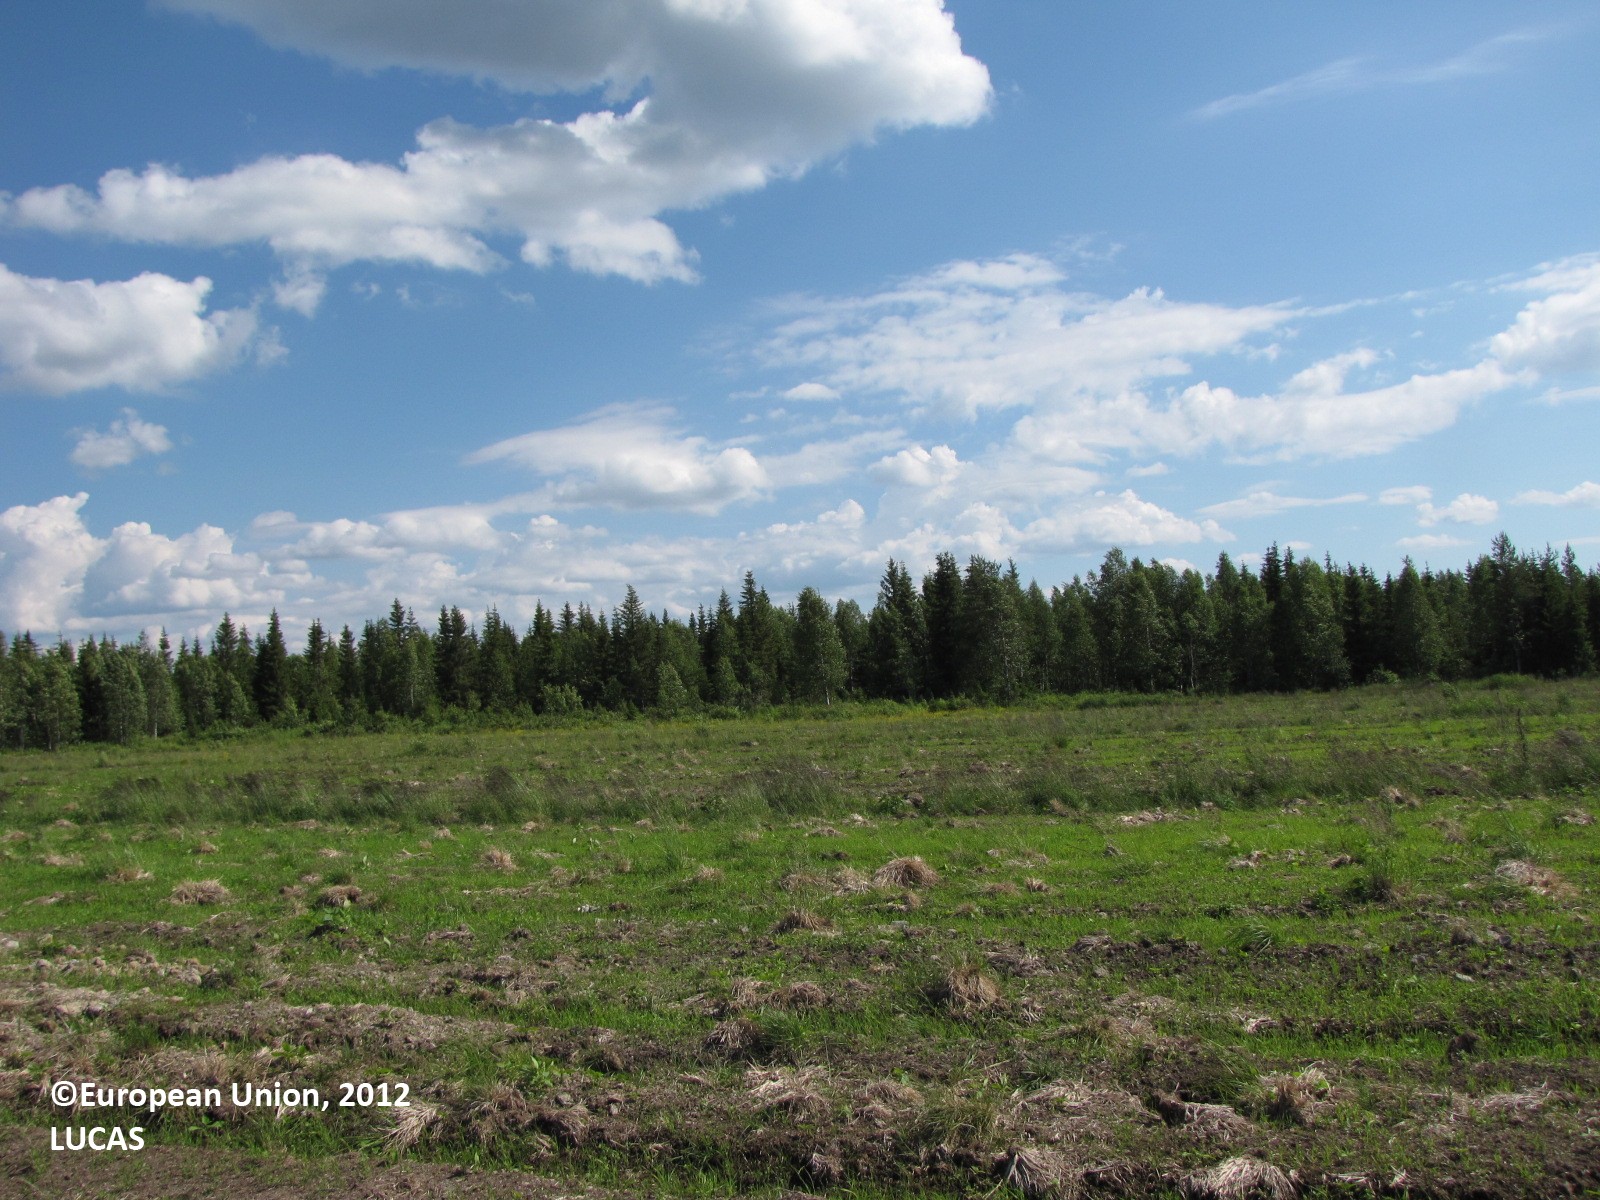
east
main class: Grassland
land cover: Grassland without tree/shrub cover
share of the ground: > 75 %
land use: Agriculture (excluding fallow land and kitchen gardens)
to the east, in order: Grassland without tree/shrub cover; Ditches and canals; Grassland without tree/shrub cover; Ditches and canals; Grassland without tree/shrub cover; Ditches and canals; Grassland without tree/shrub cover; Ditches and canals; Other bare soil; Ditches and canals; Grassland with sparse tree/shrub cover; Spruce dominated mixed woodland; Ditches and canals; Spruce dominated mixed woodland; Ditches and canals; Spruce dominated mixed woodland; Ditches and canals; Spruce dominated coniferous woodland
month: July
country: FI
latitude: 66.2650
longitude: 25.2235
